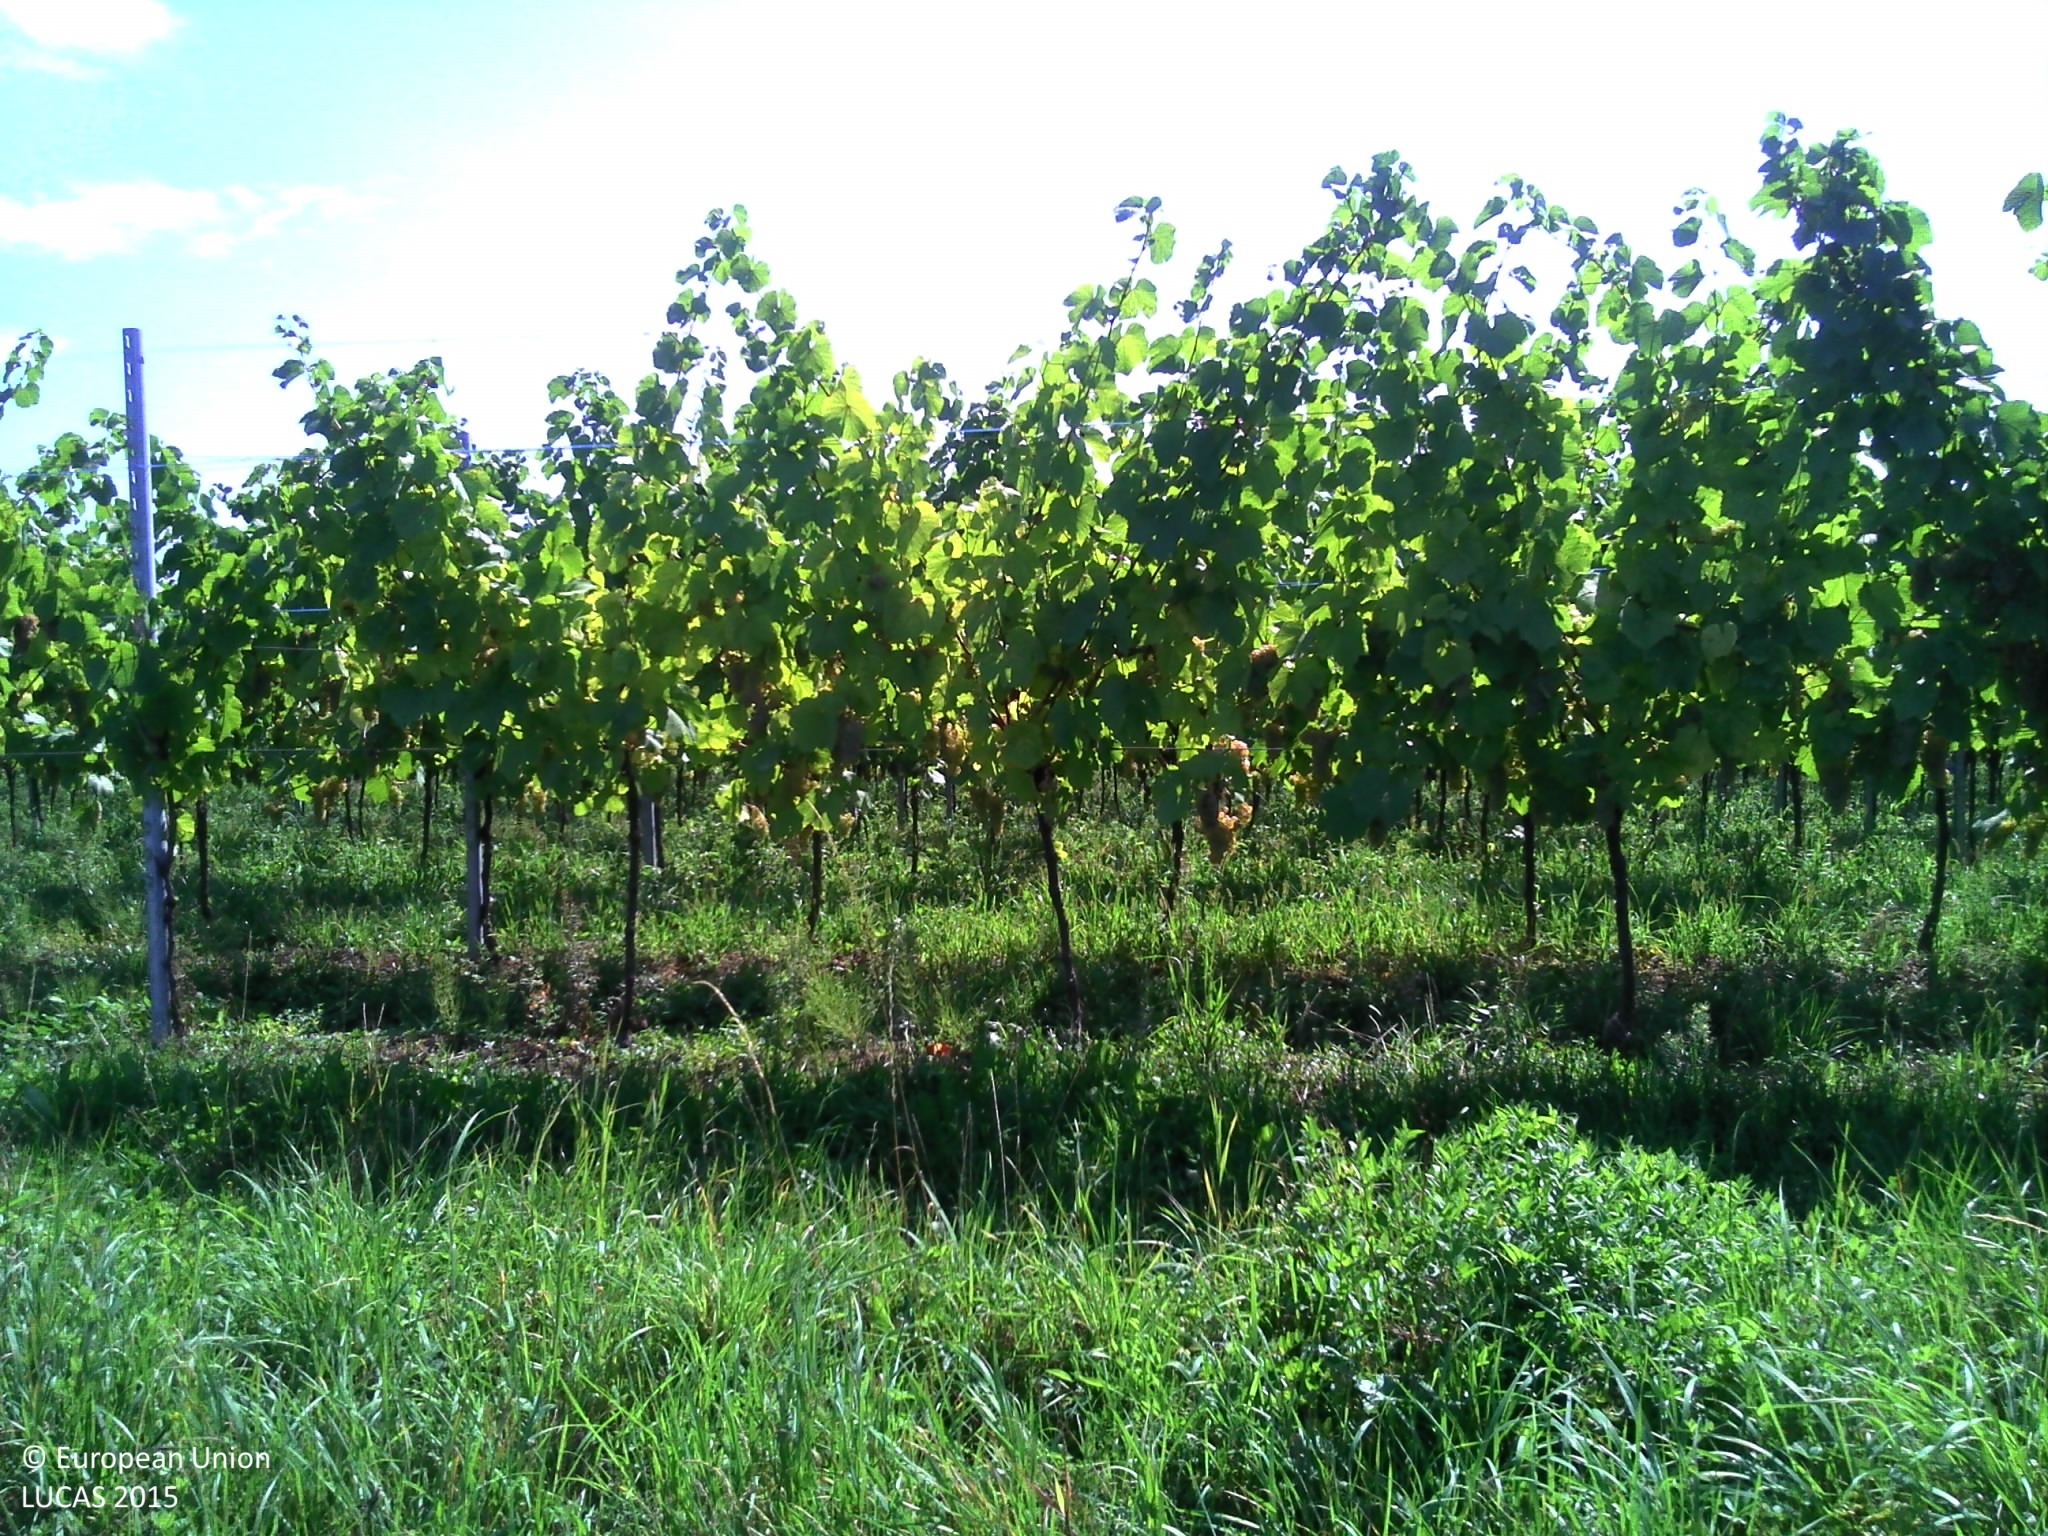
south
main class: Grassland
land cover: Grassland with sparse tree/shrub cover
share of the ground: > 75 %
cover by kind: herbaceous plants 95 %, broadleaved forest trees 5 %
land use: Agriculture (excluding fallow land and kitchen gardens)
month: August
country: FR
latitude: 48.3567
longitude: 7.4772
